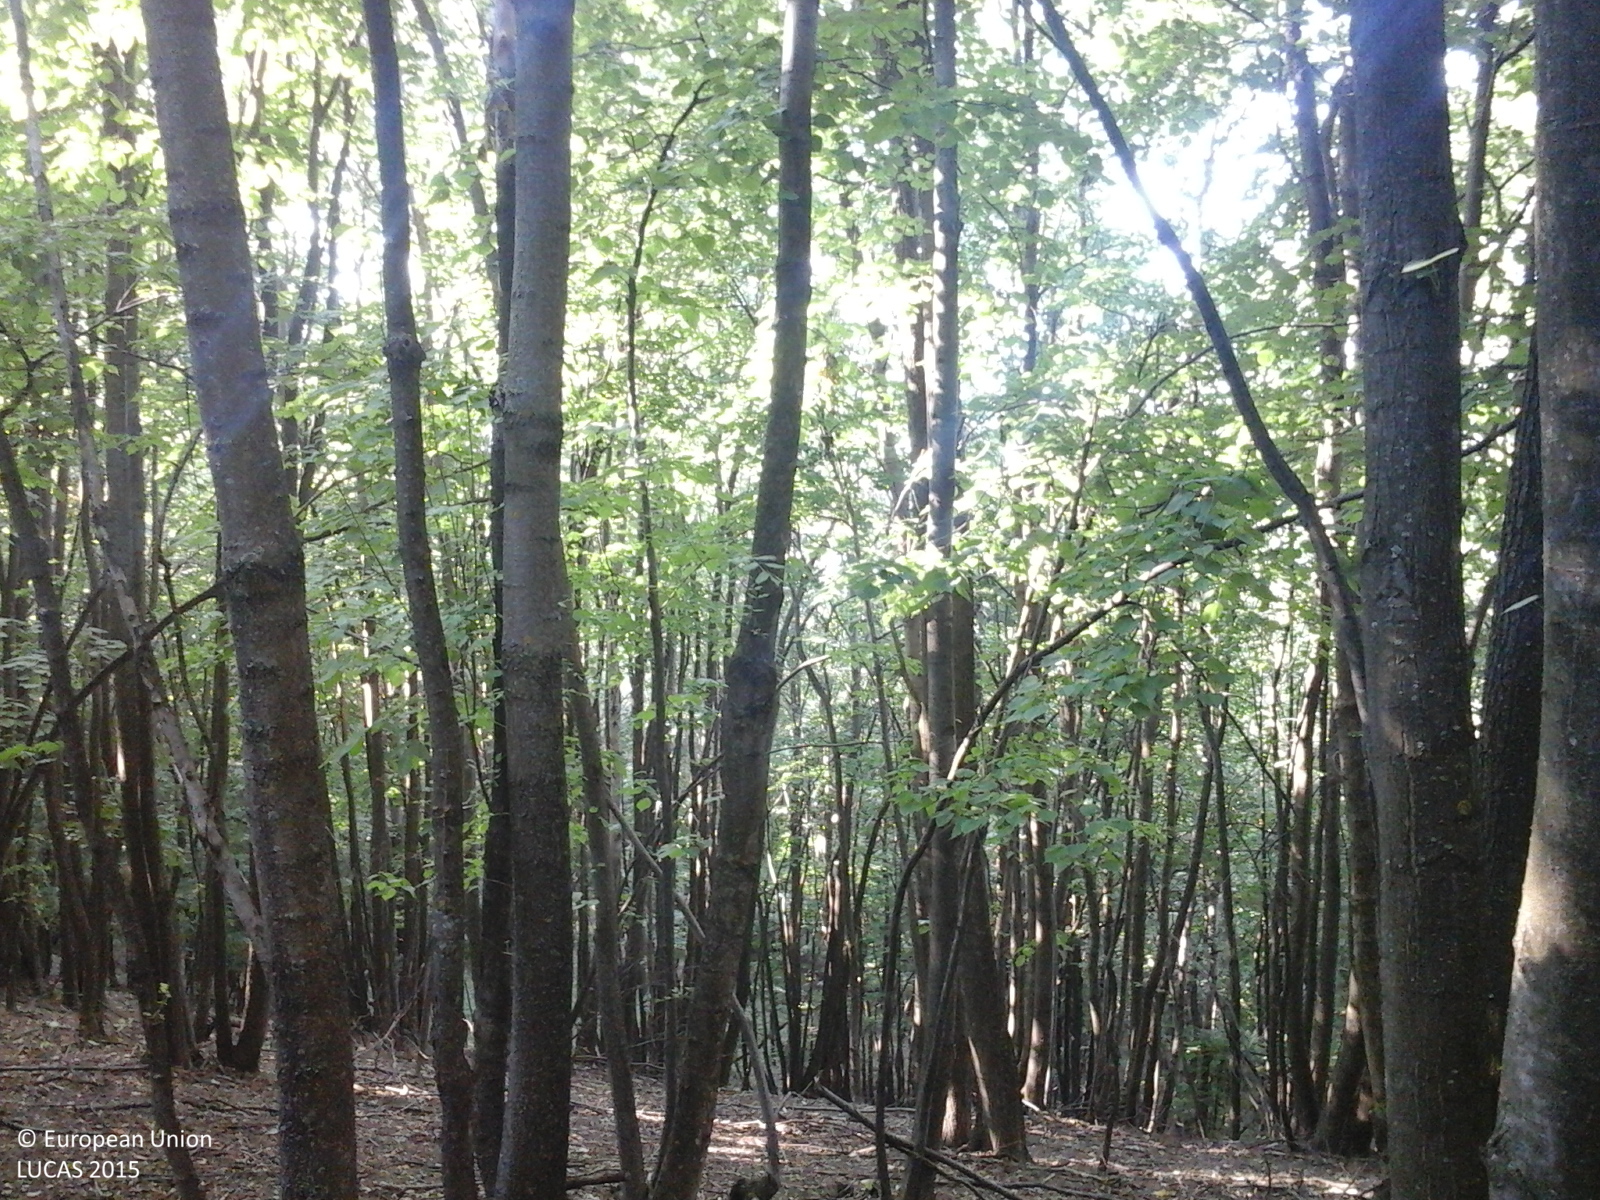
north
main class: Woodland
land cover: Broadleaved woodland
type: mesophytic deciduous forest
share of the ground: > 75 %
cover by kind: broadleaved forest trees 100 %
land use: Forestry
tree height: > 5 m
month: June
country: RO
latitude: 46.9445
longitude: 27.9020
